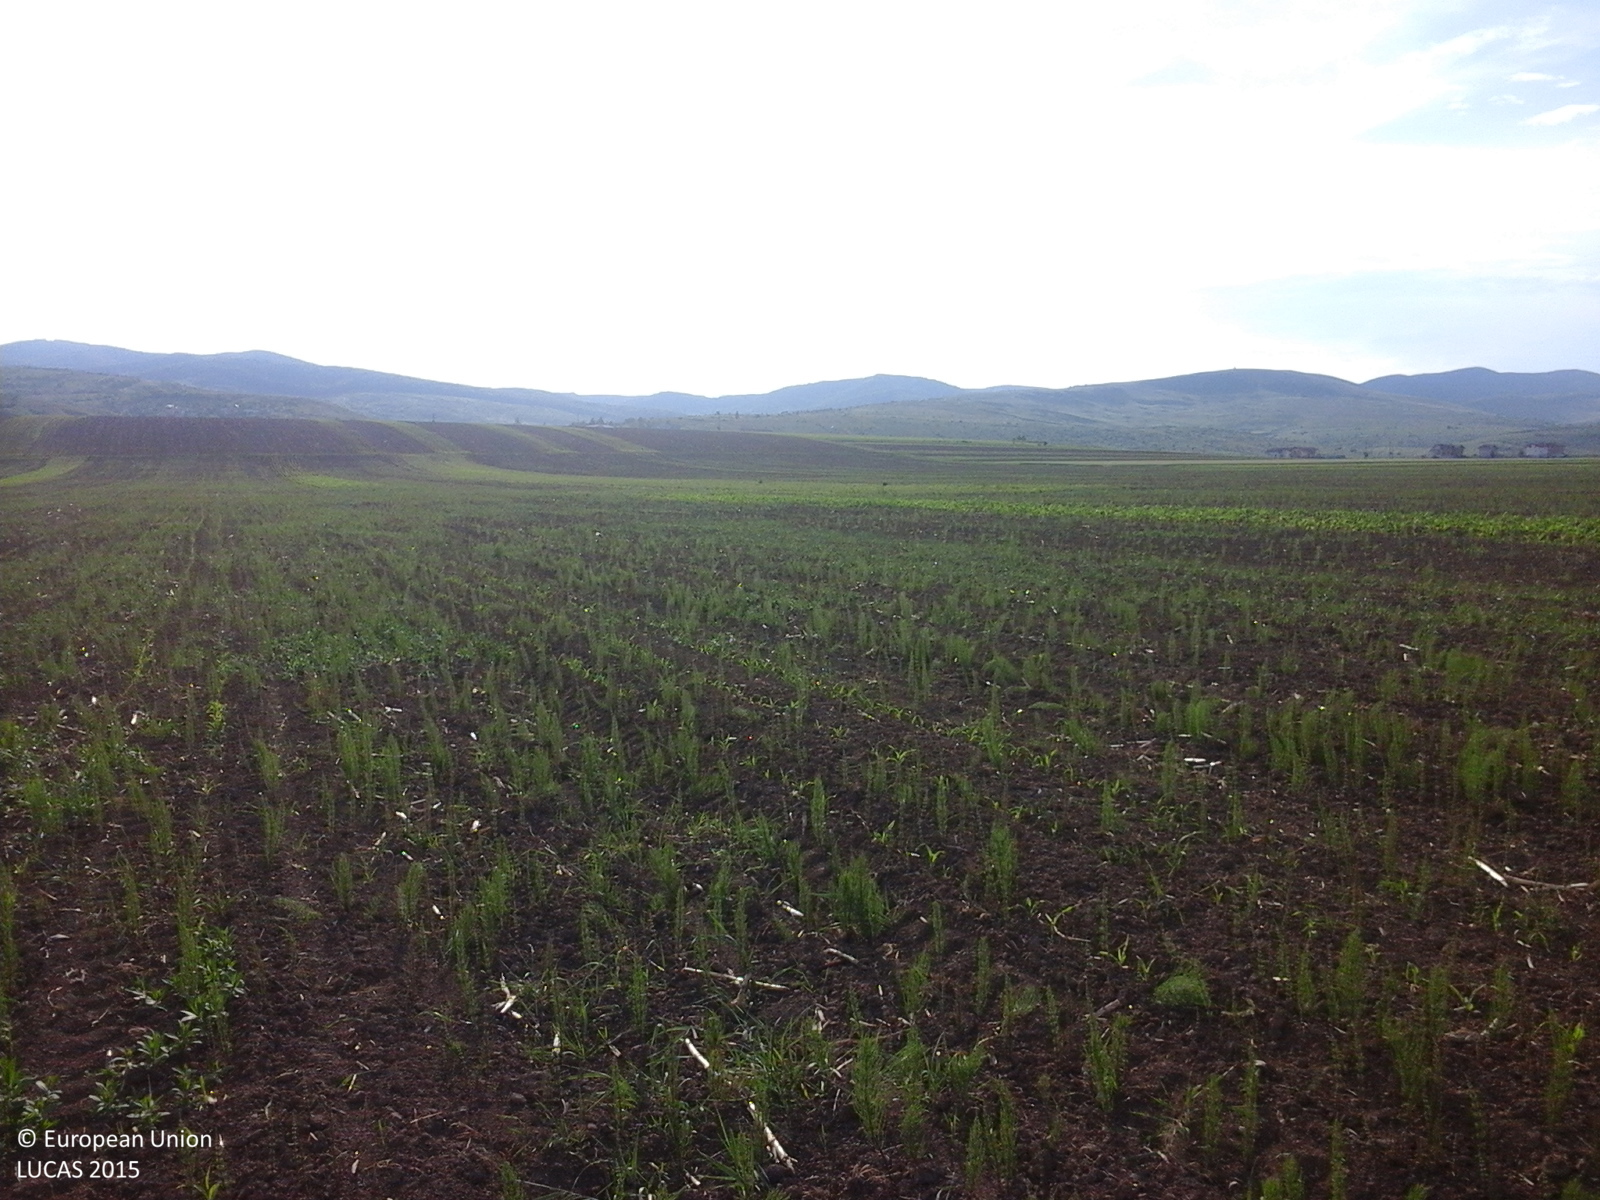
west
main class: Cropland
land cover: Maize
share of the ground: < 10 %
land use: Agriculture (excluding fallow land and kitchen gardens)
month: June
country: RO
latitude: 46.4642
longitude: 26.9039
